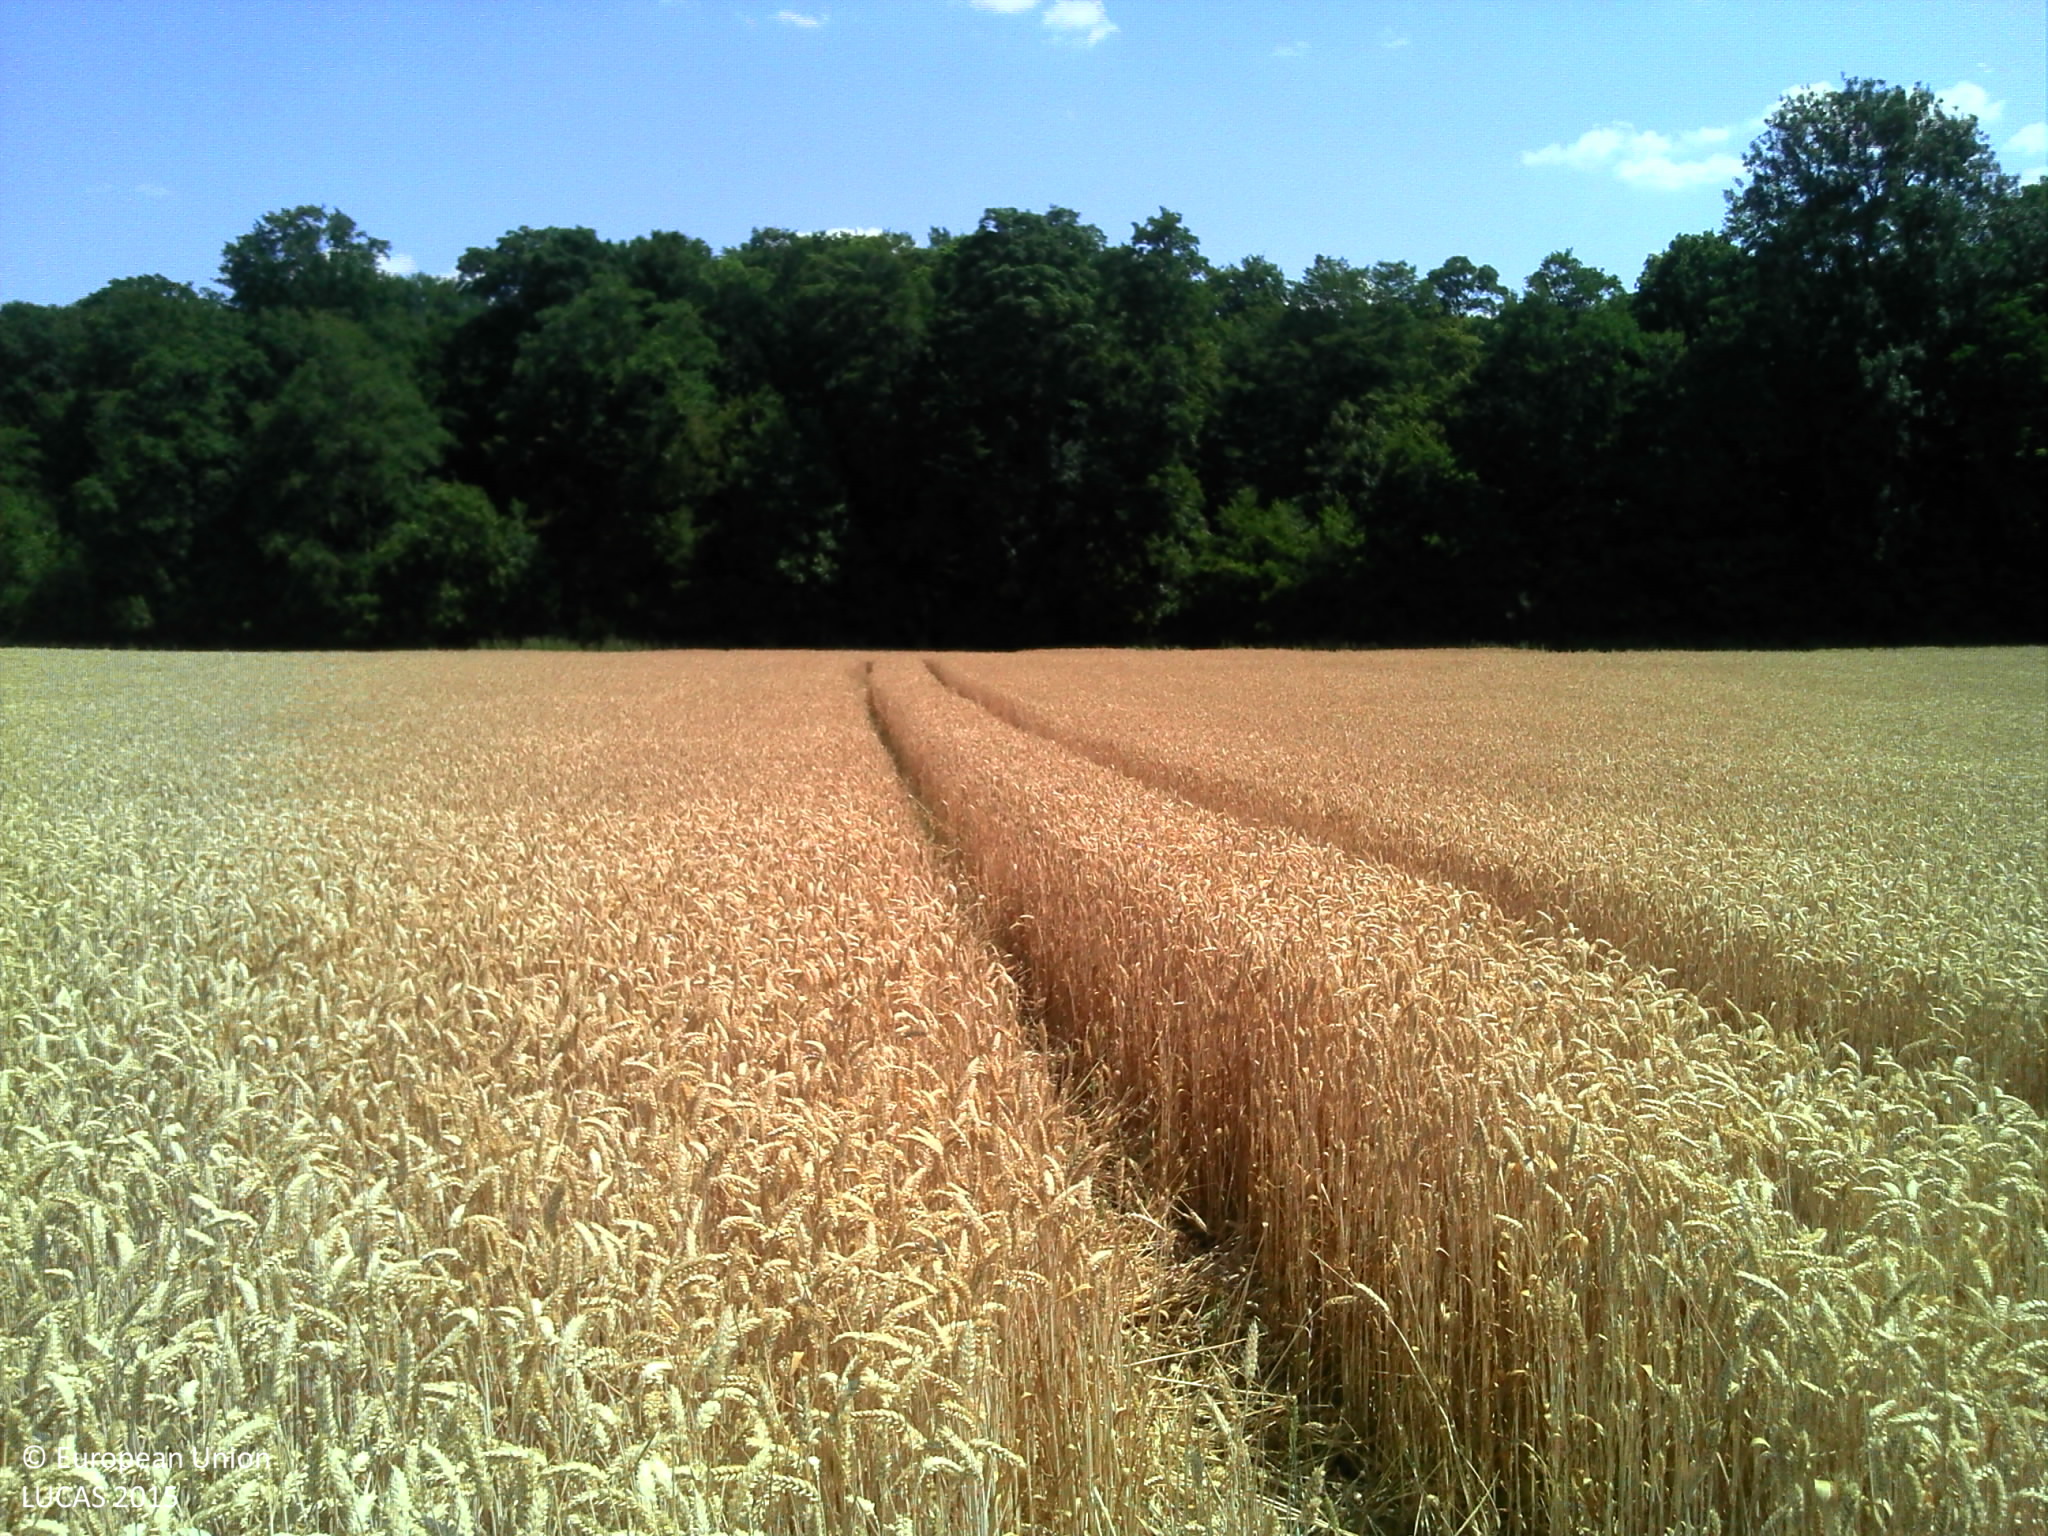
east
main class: Cropland
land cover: Common wheat
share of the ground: > 75 %
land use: Agriculture (excluding fallow land and kitchen gardens)
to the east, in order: Common wheat; Grassland without tree/shrub cover; Ditches and canals; Broadleaved woodland
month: July
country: FR
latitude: 49.0166
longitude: 5.1167
